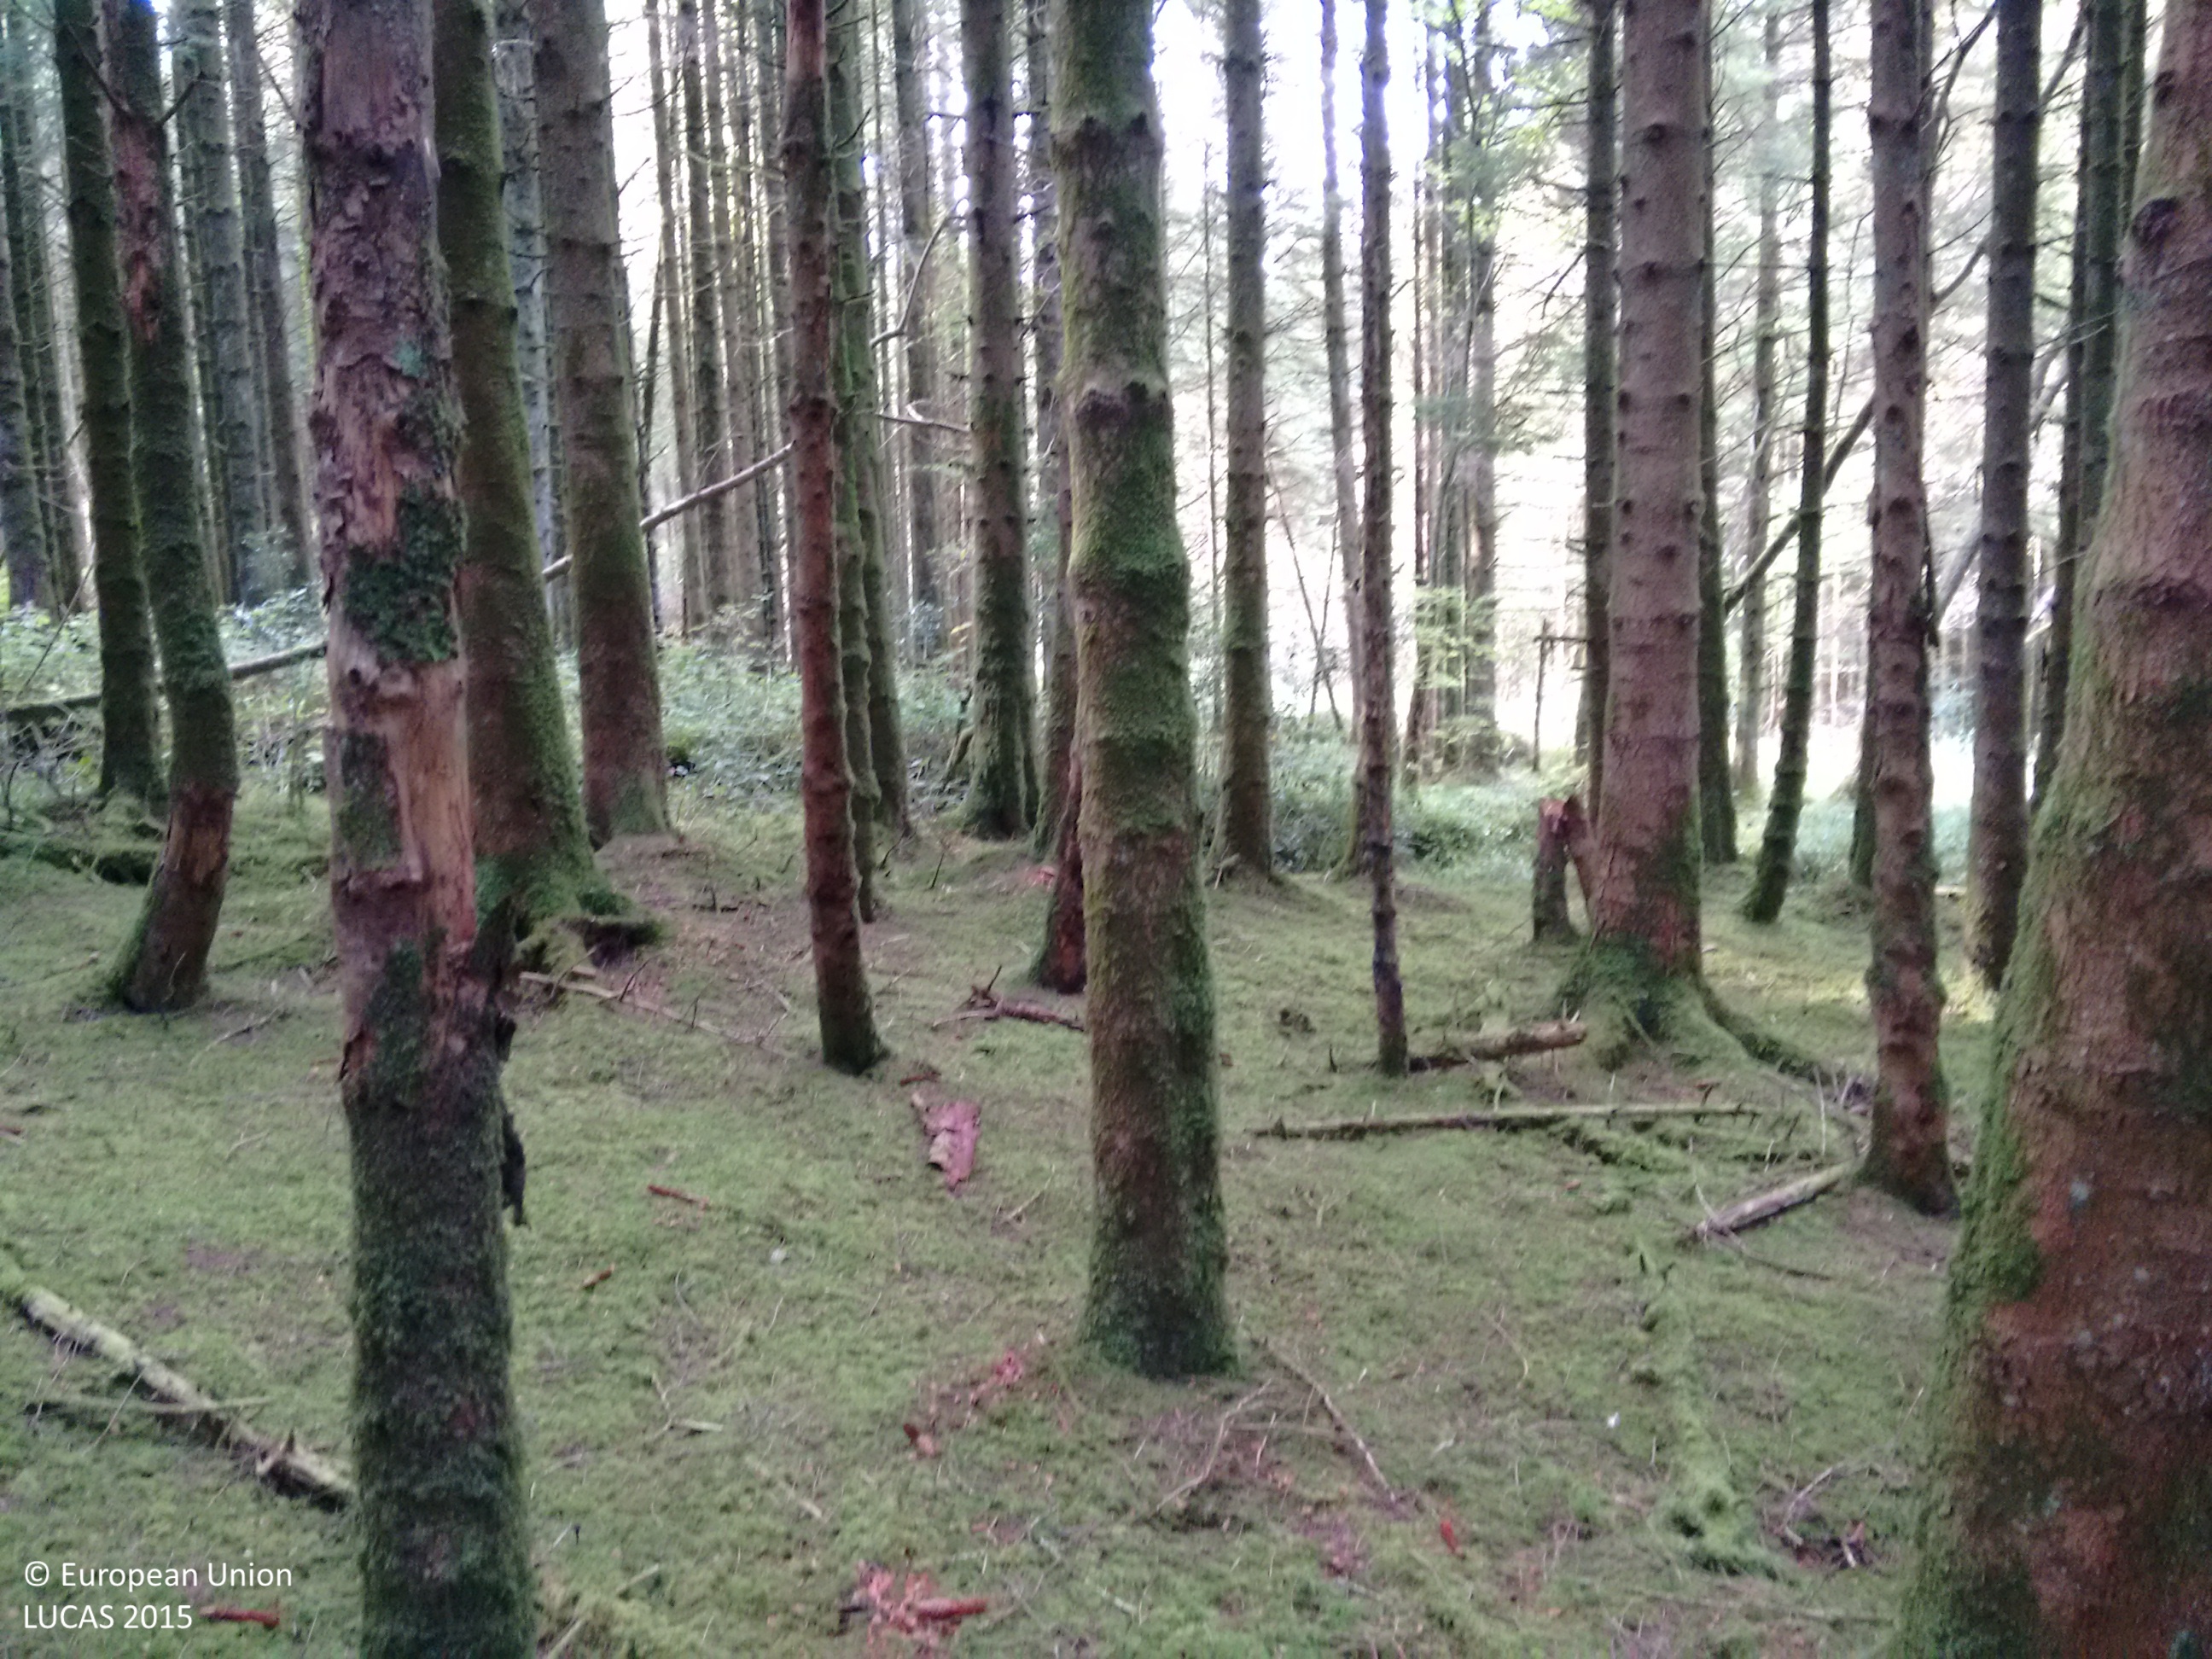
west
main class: Woodland
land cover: Spruce dominated coniferous woodland
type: exotic forest
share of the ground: > 75 %
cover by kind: coniferous forest trees 100 %
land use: Forestry
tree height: > 5 m
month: October
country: GB
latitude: 54.3310
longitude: -7.8370
